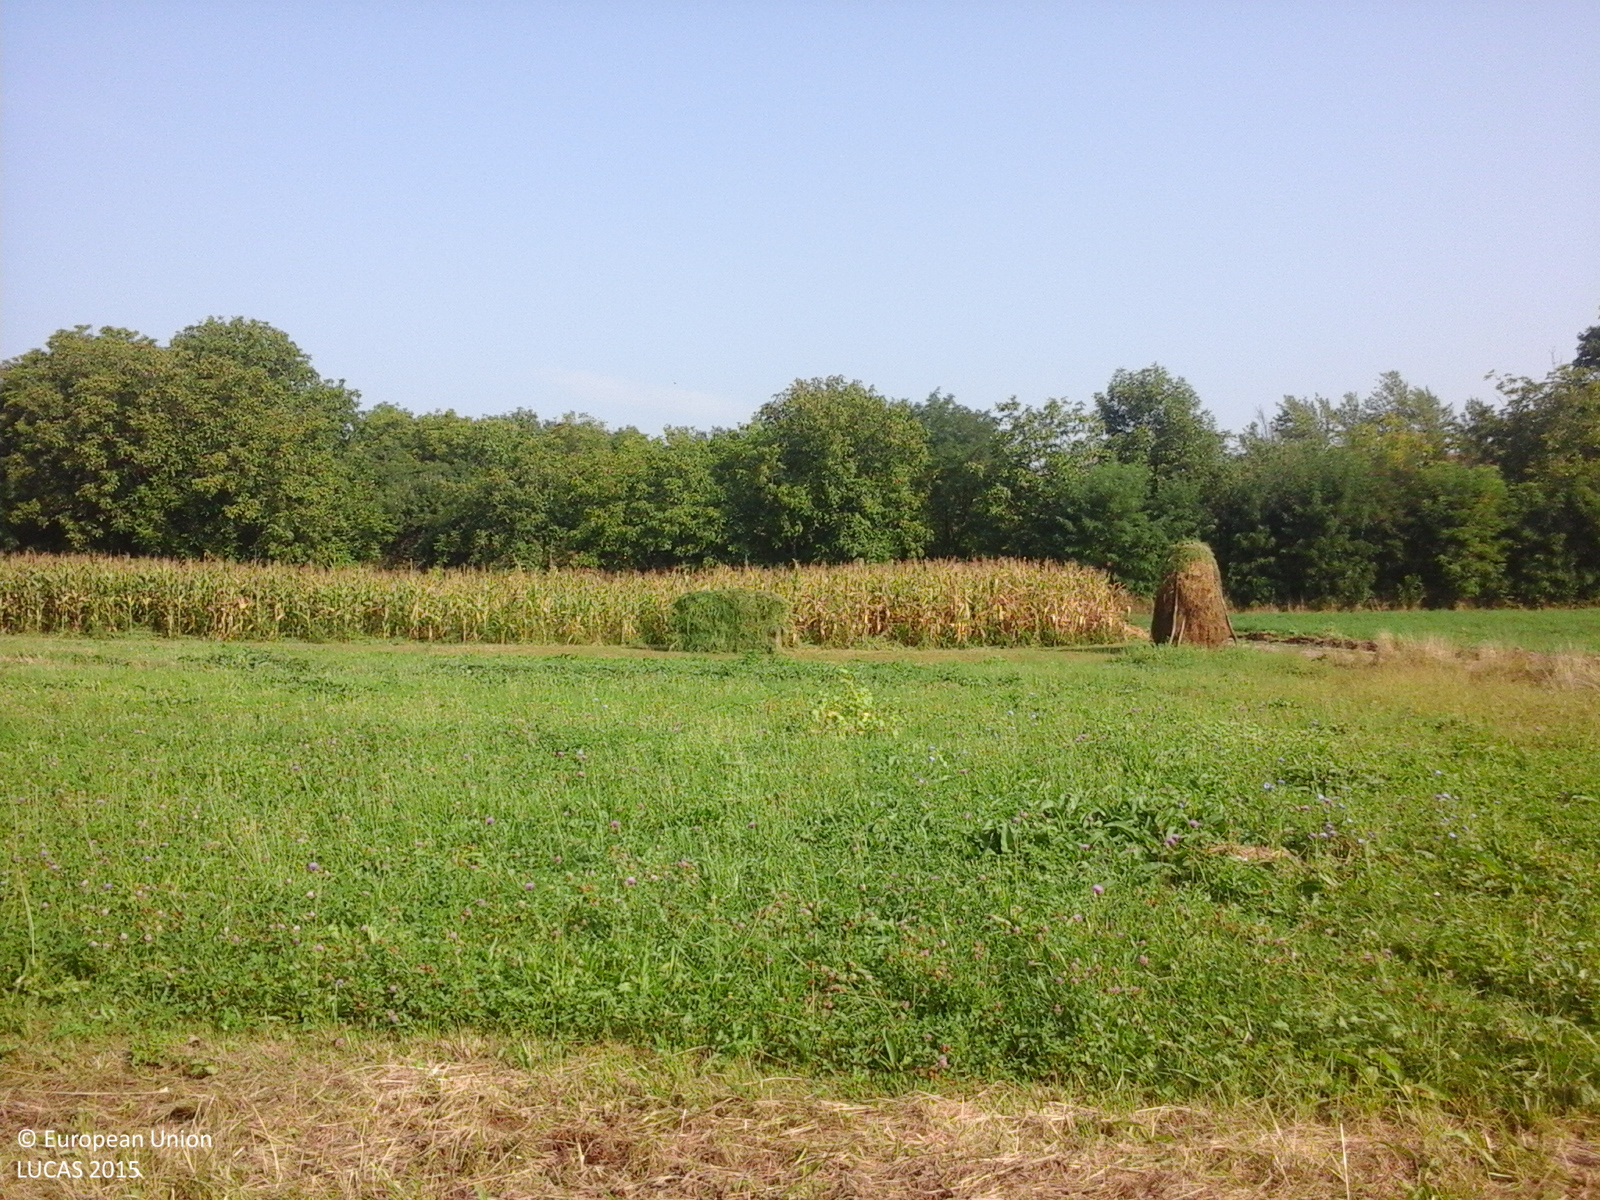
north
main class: Grassland
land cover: Grassland without tree/shrub cover
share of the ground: > 75 %
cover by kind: herbaceous plants 100 %
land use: Agriculture (excluding fallow land and kitchen gardens)
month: September
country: RO
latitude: 47.1789
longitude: 24.1368
